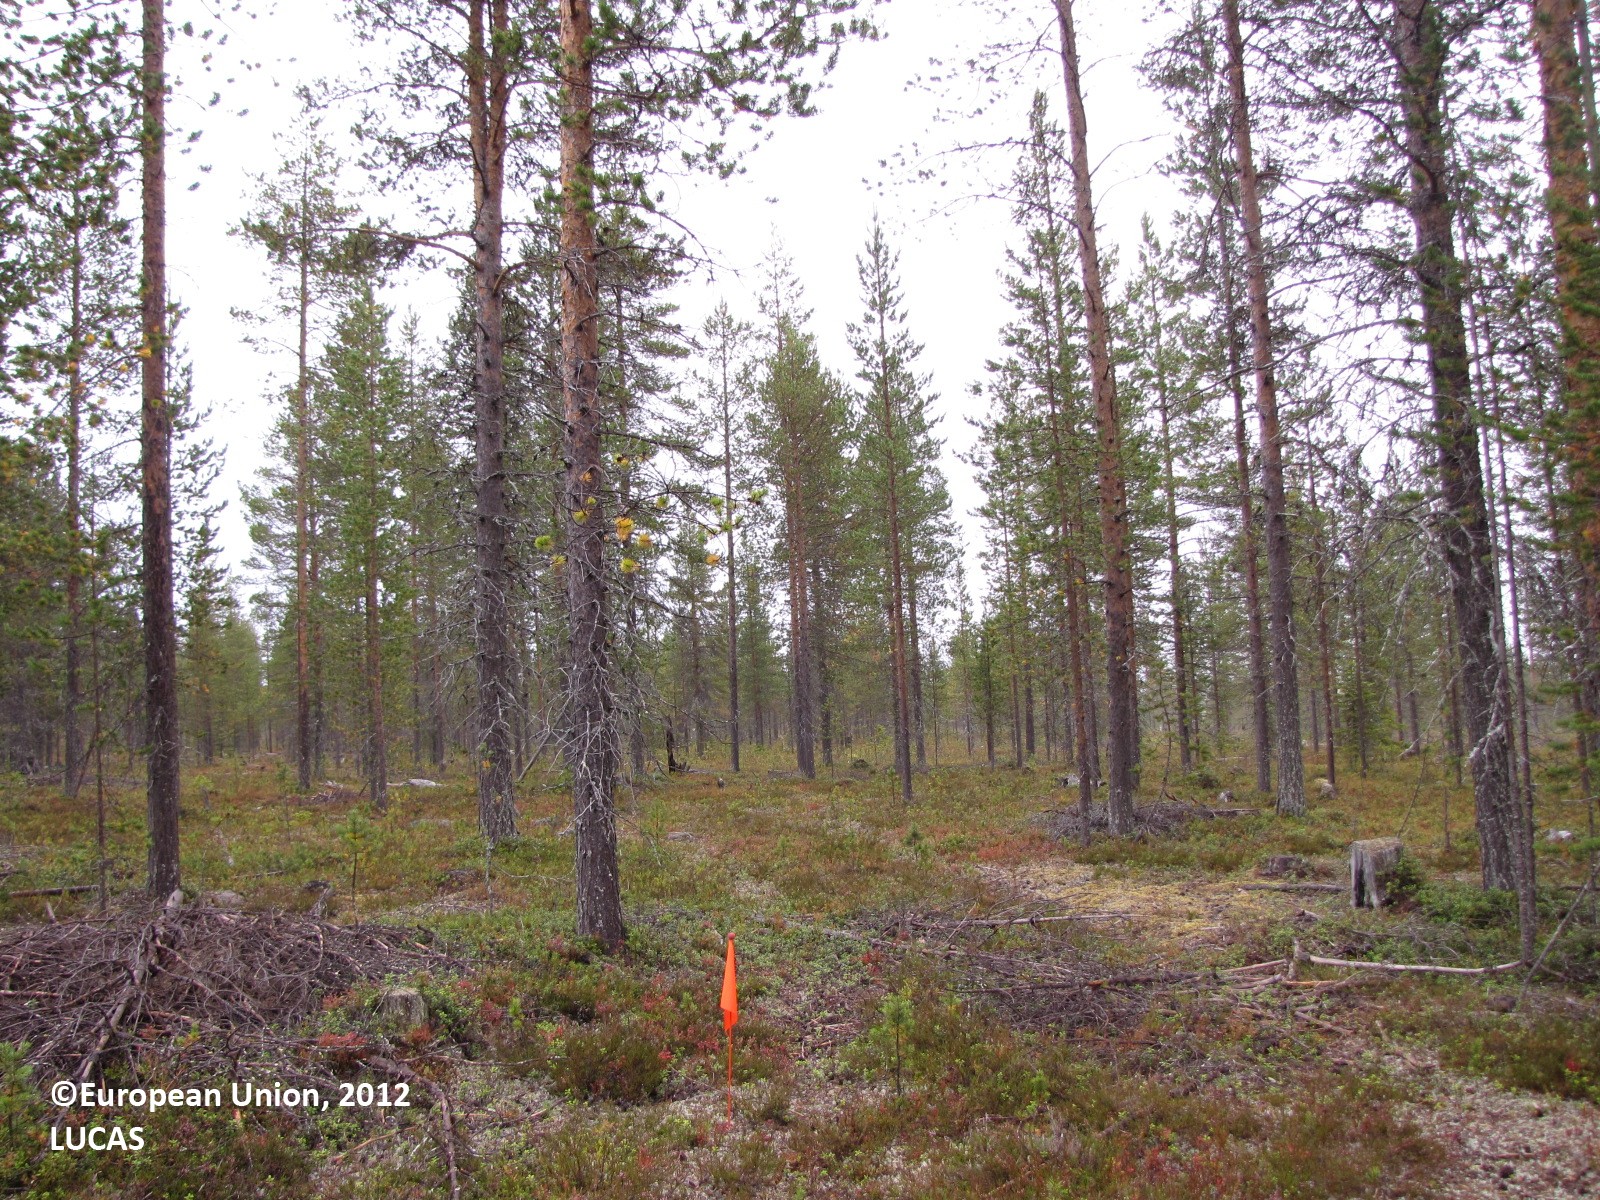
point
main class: Woodland
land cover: Pine dominated coniferous woodland
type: boreal forest
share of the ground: 25 - 50 %
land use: Forestry
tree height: > 5 m
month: August
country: FI
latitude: 67.0988
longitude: 24.8027
